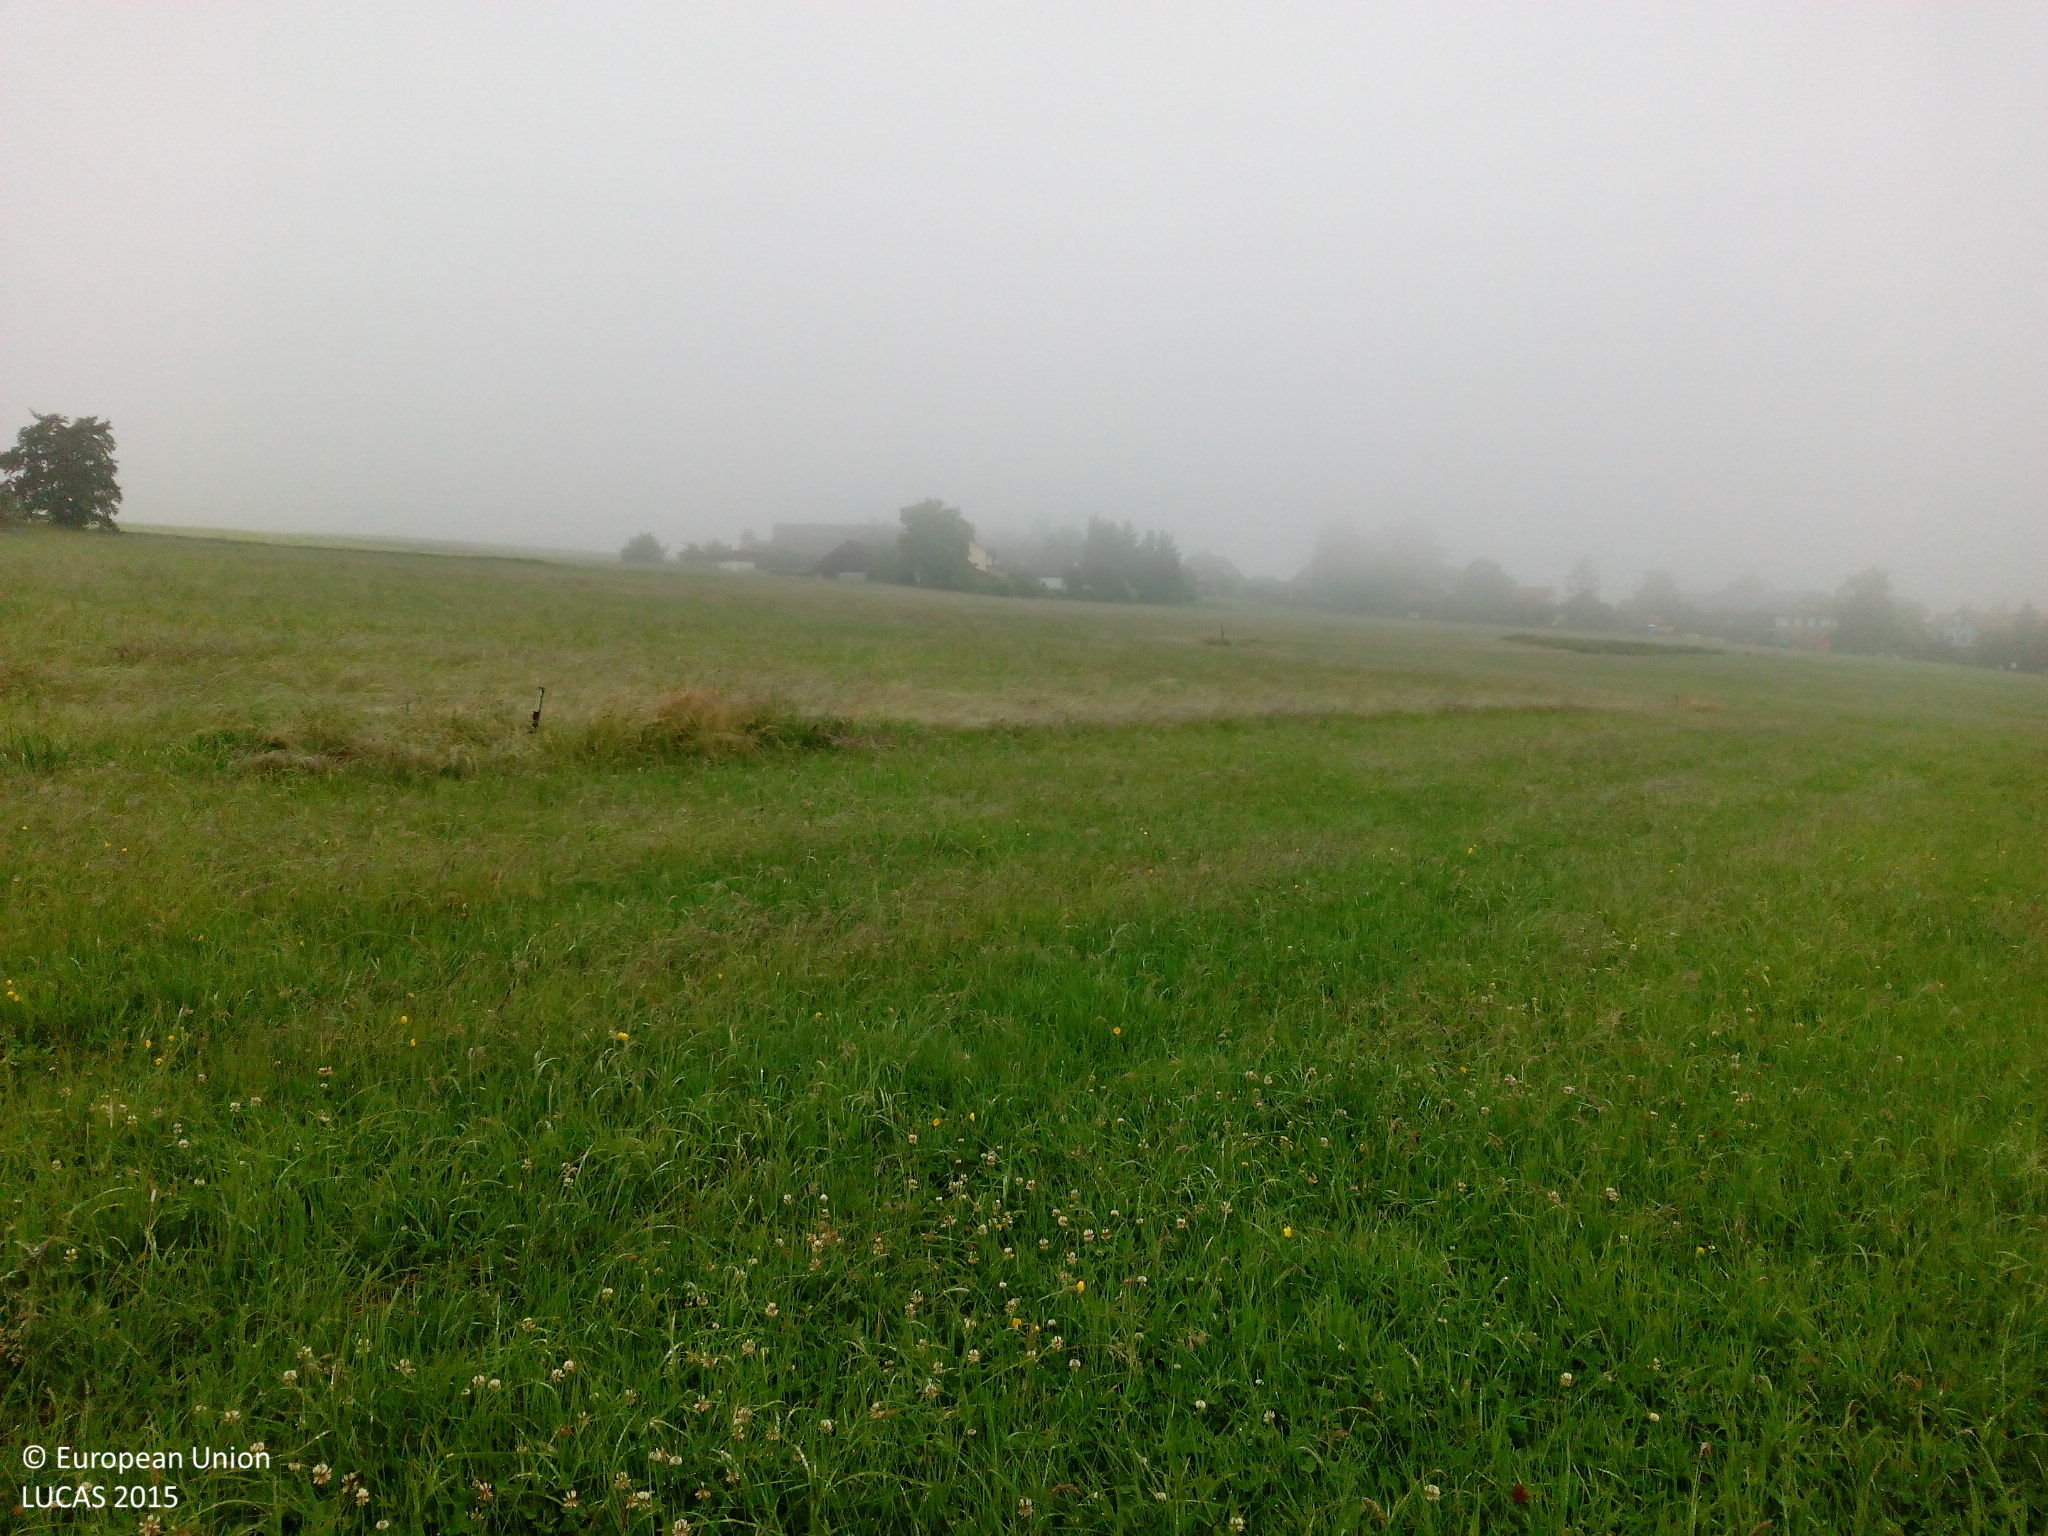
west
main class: Grassland
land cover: Grassland without tree/shrub cover
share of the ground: > 75 %
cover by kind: herbaceous plants 100 %
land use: Agriculture (excluding fallow land and kitchen gardens)
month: June
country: DE
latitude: 50.0845
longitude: 11.4950
